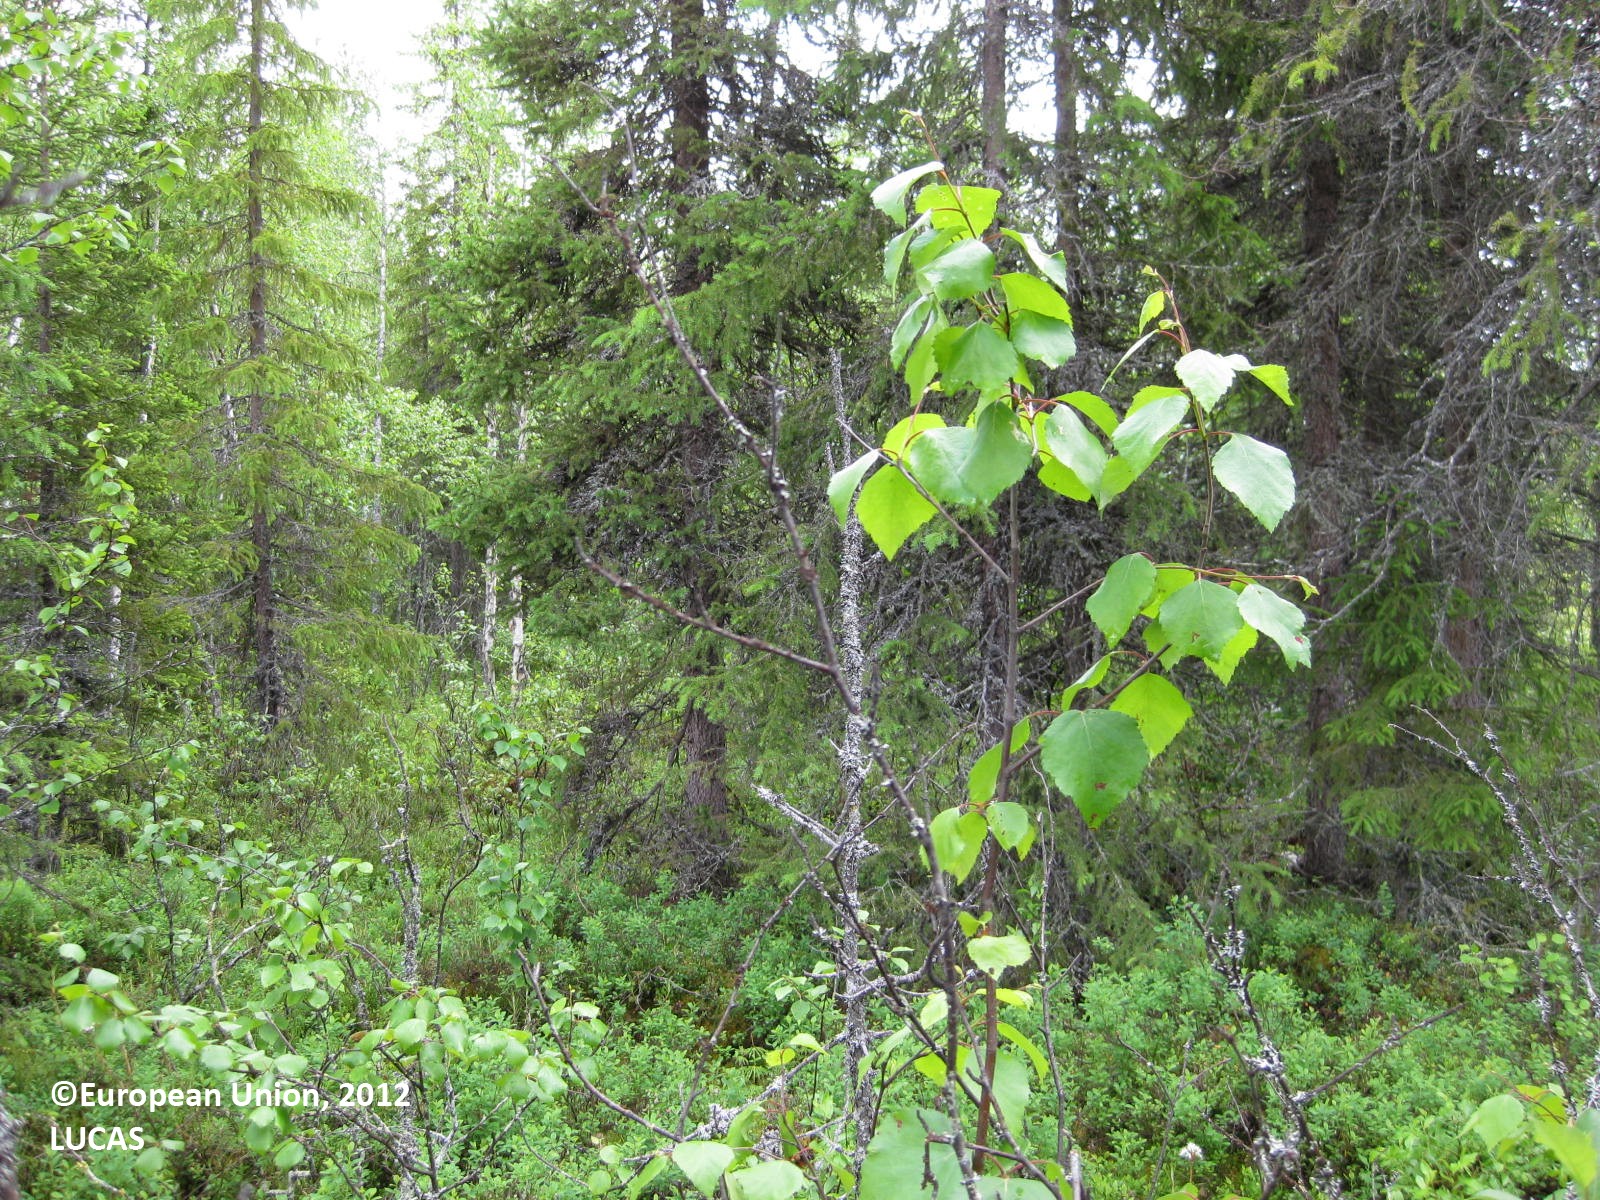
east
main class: Woodland
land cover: Other mixed woodland
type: boreal forest
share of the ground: > 75 %
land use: Forestry
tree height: > 5 m
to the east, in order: Other mixed woodland; Pine dominated mixed woodland; Other mixed woodland; Ditches and canals; Other mixed woodland; Pine dominated coniferous woodland; Ditches and canals; Pine dominated coniferous woodland
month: June
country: FI
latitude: 65.1444
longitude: 28.1726
